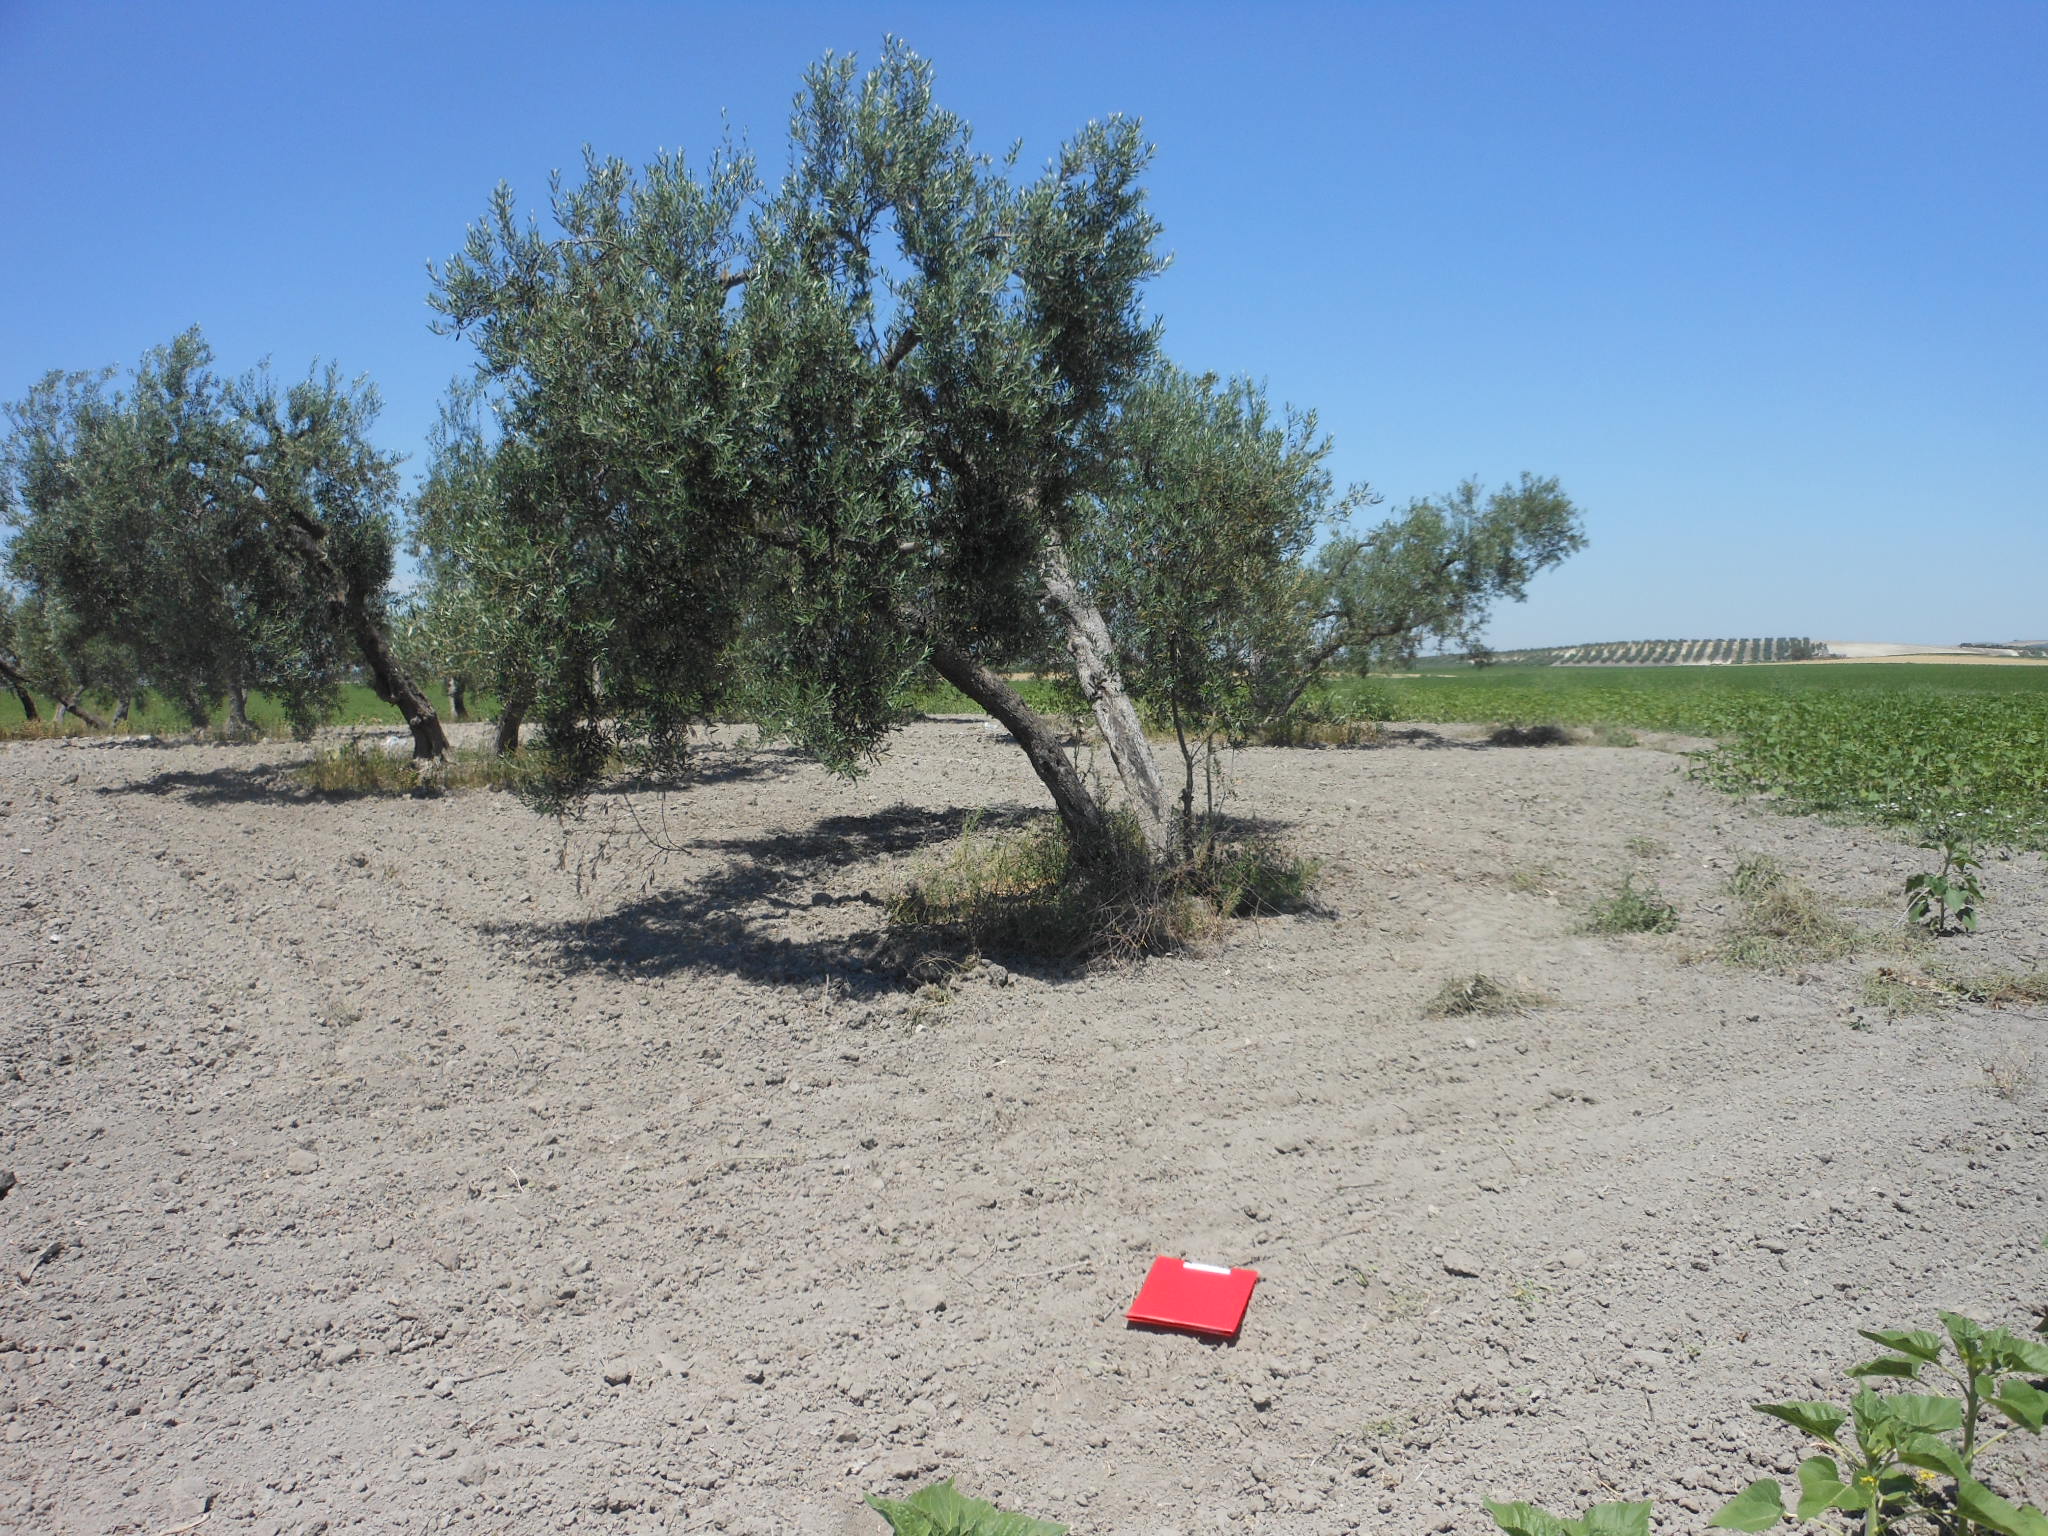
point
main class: Cropland
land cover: Olive groves
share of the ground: 10 - 25 %
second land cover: Other bare soil
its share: > 75 %
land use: Agriculture (excluding fallow land and kitchen gardens)
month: May
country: ES
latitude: 37.3035
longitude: -5.5734
